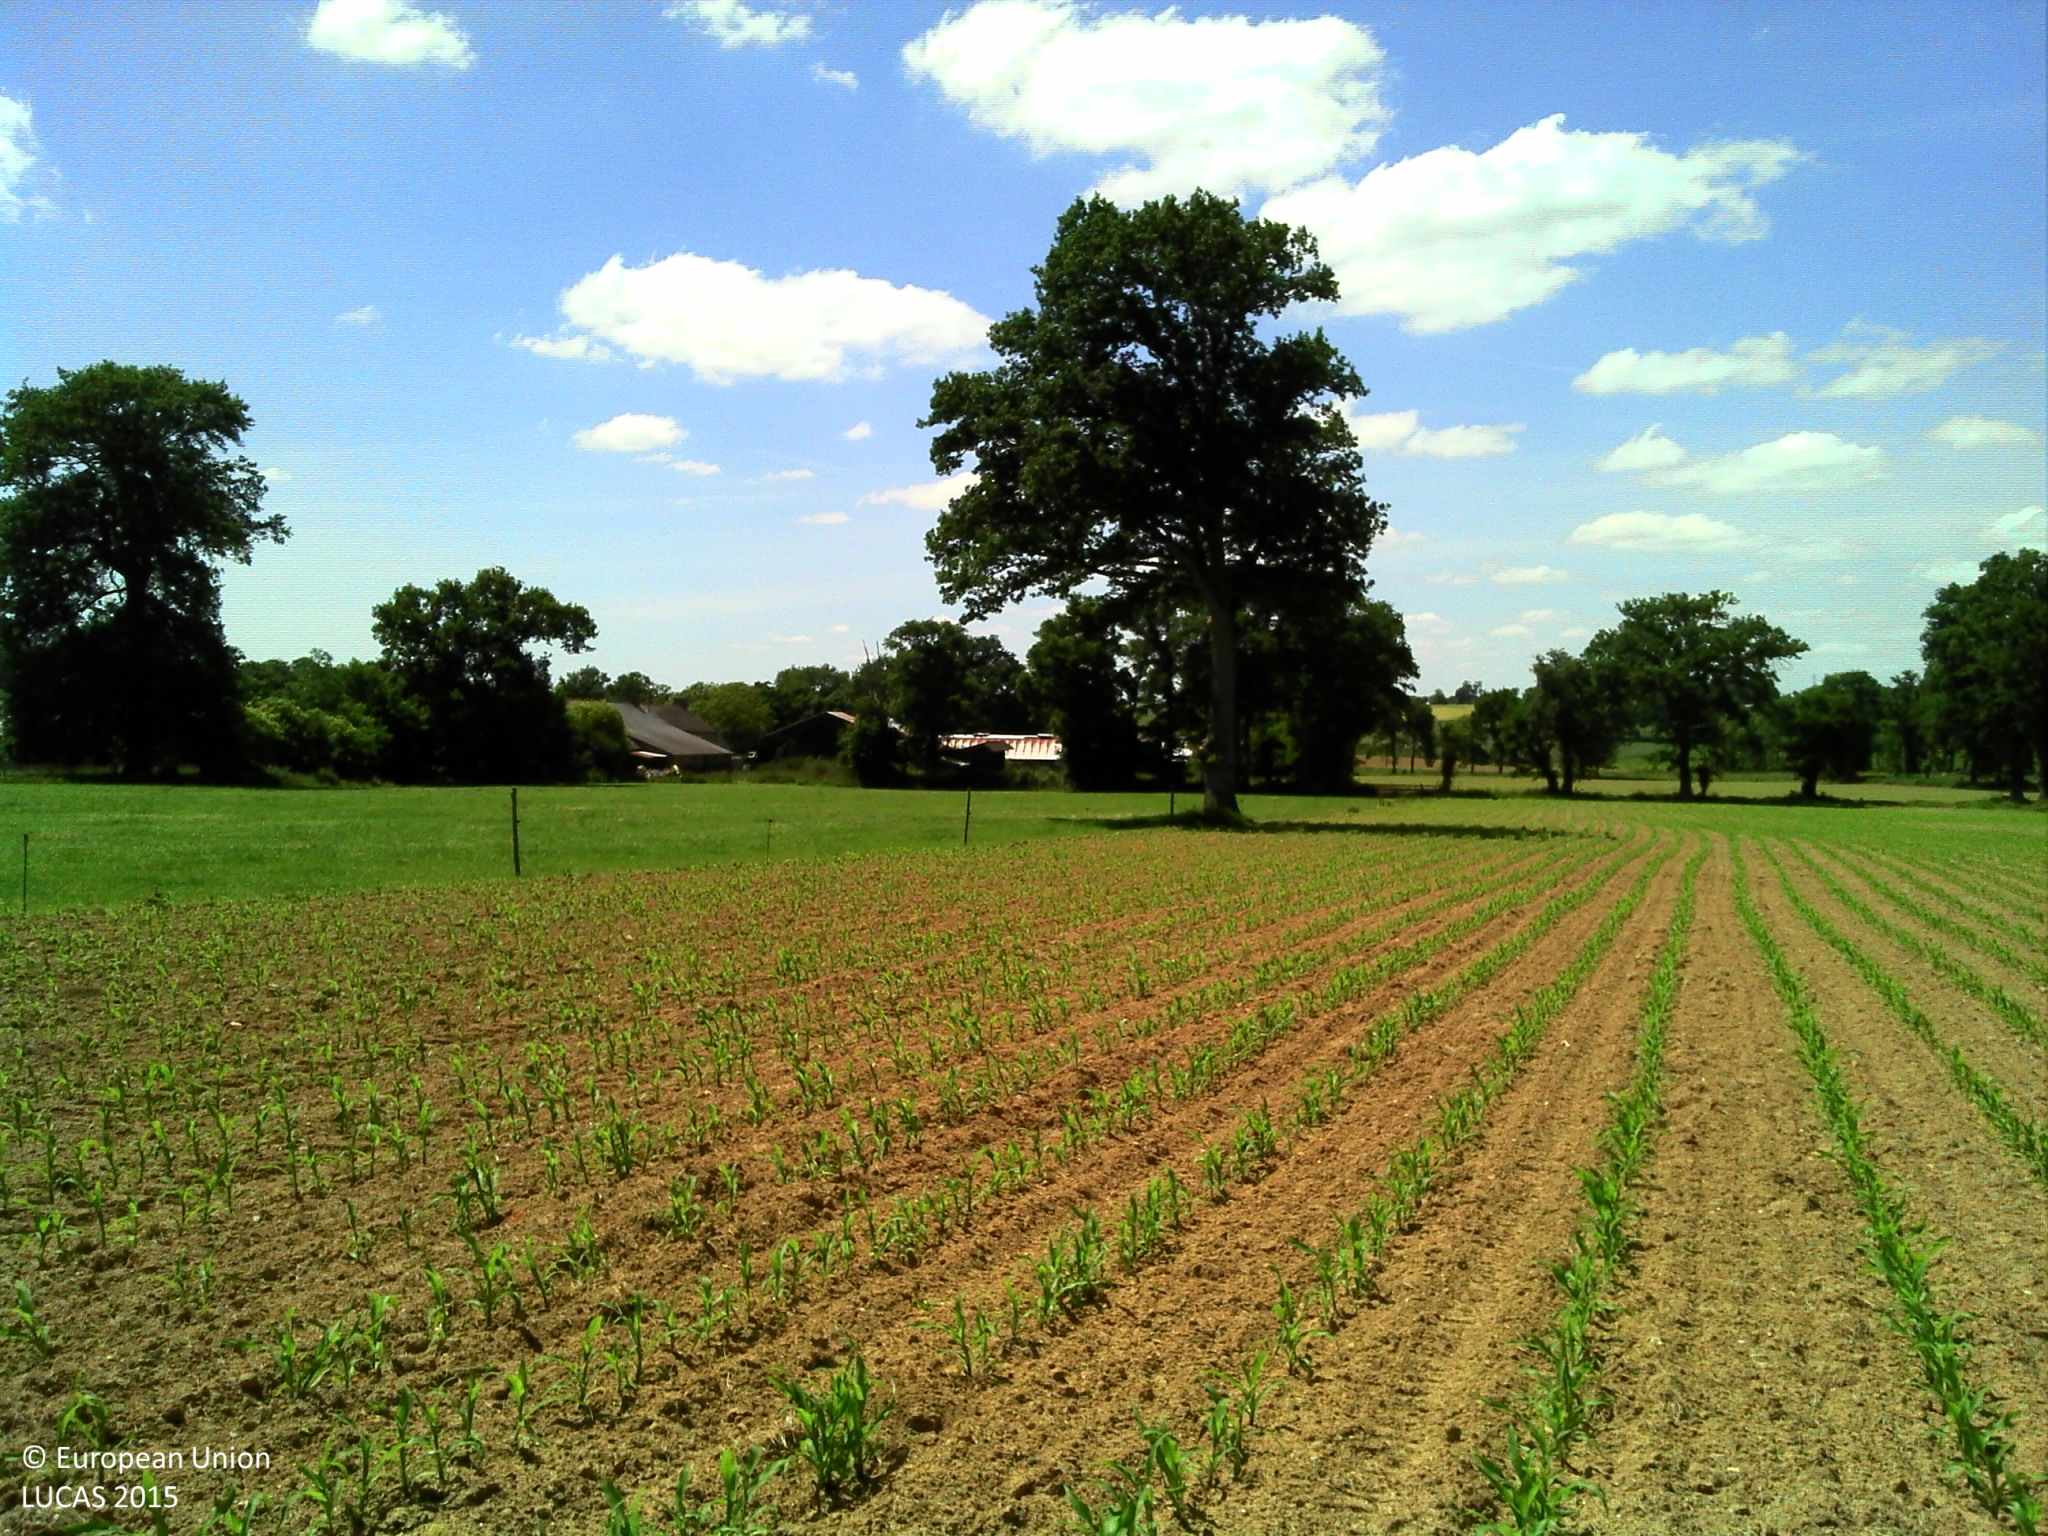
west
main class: Cropland
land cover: Maize
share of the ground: > 75 %
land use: Agriculture (excluding fallow land and kitchen gardens)
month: June
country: FR
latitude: 48.1305
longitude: -1.4798
